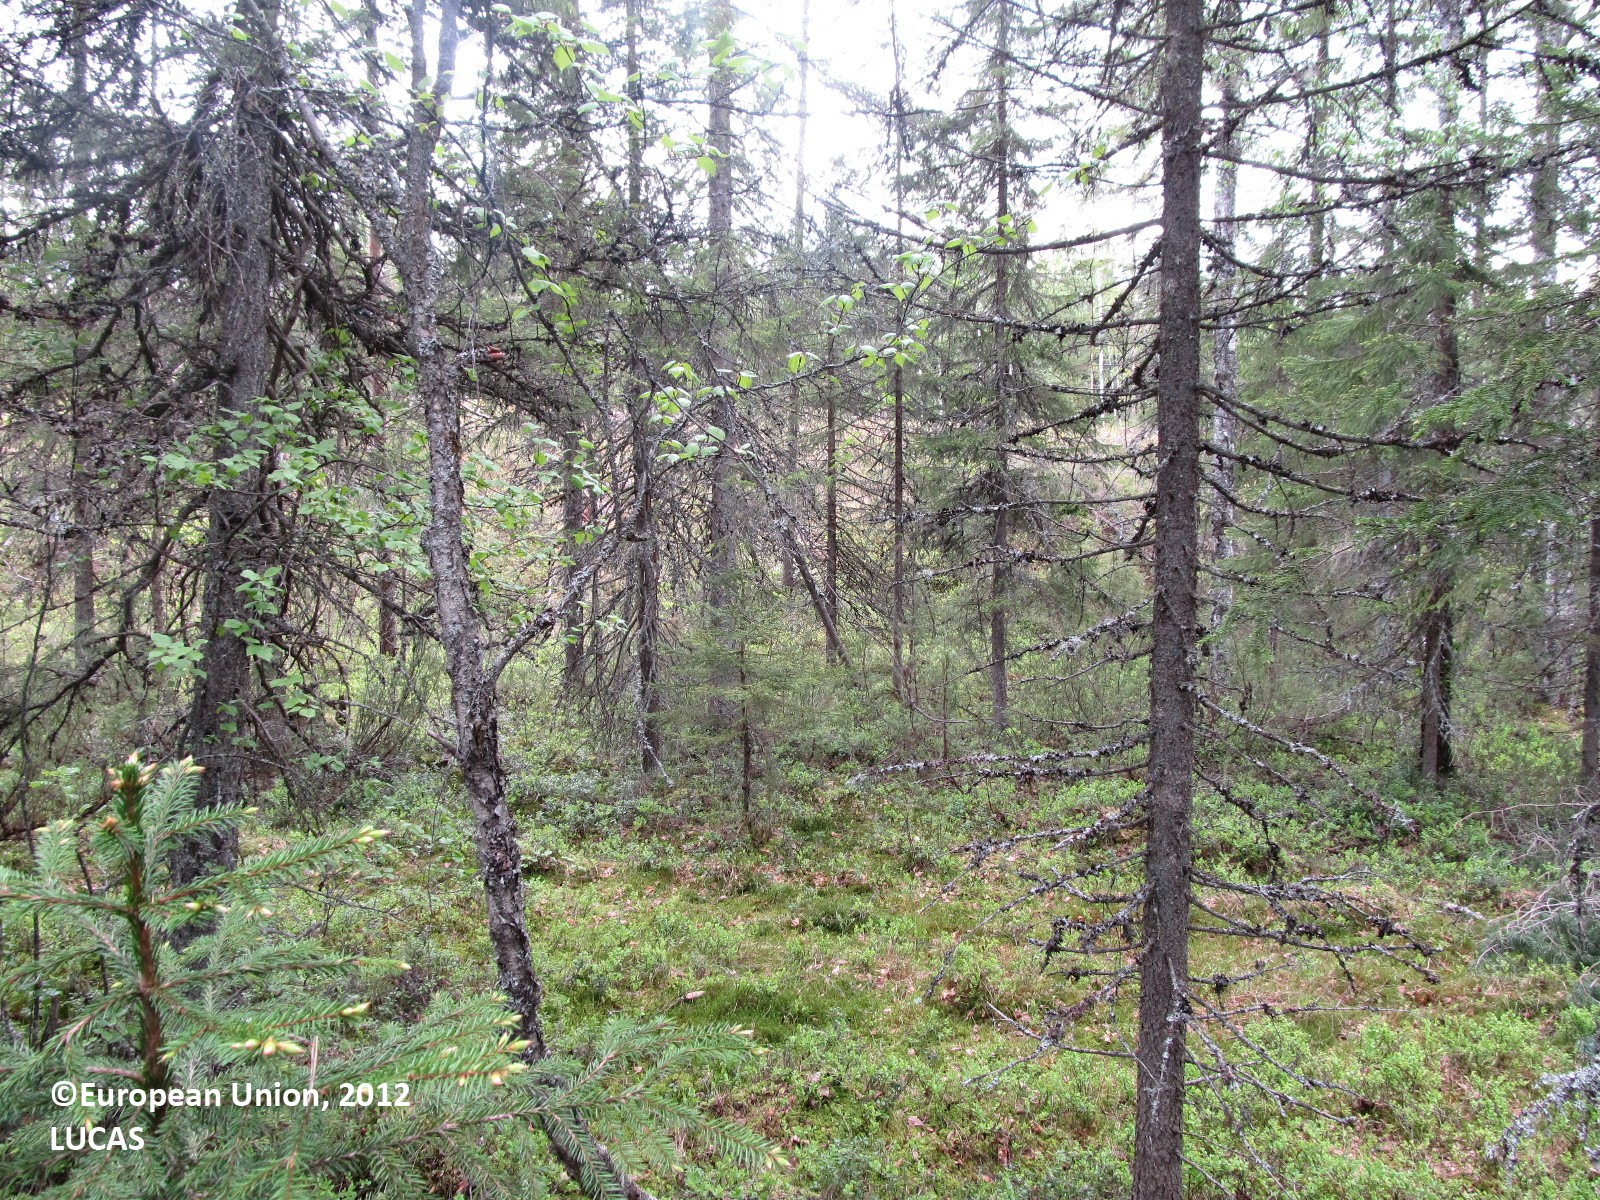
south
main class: Woodland
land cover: Spruce dominated coniferous woodland
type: boreal forest
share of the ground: 50 - 75 %
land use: Forestry
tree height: > 5 m
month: June
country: FI
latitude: 63.2592
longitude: 29.0783
